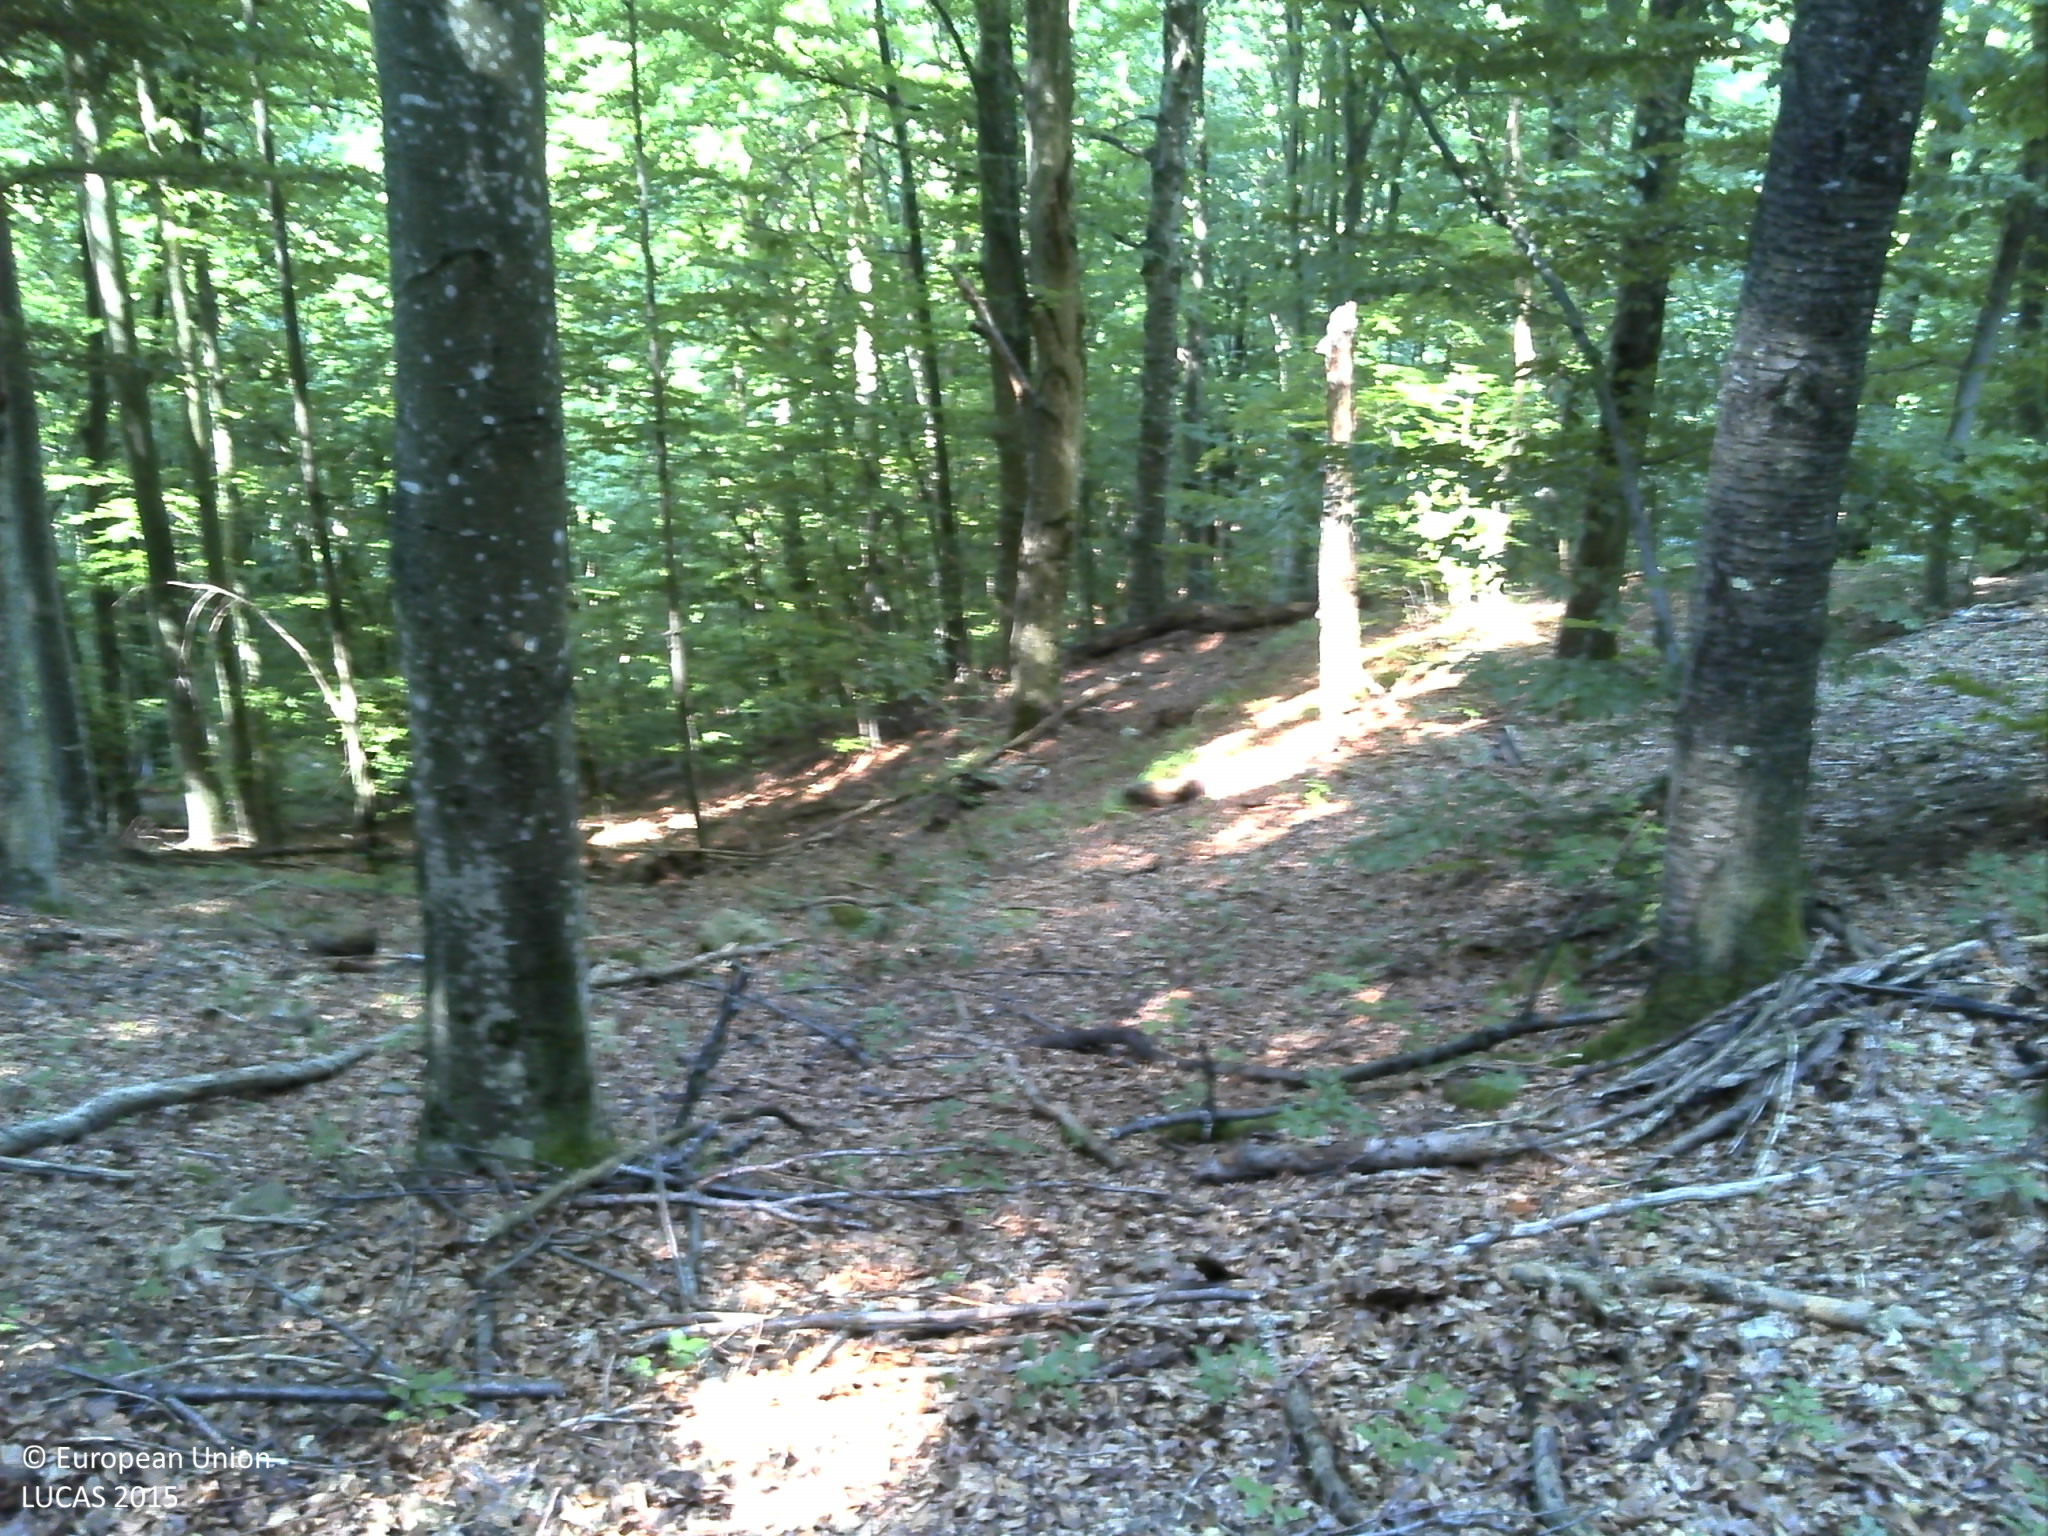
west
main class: Woodland
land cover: Broadleaved woodland
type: beech forest
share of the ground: > 75 %
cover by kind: broadleaved forest trees 100 %
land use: Forestry
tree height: > 5 m
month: August
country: HR
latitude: 45.5544
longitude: 17.3669
